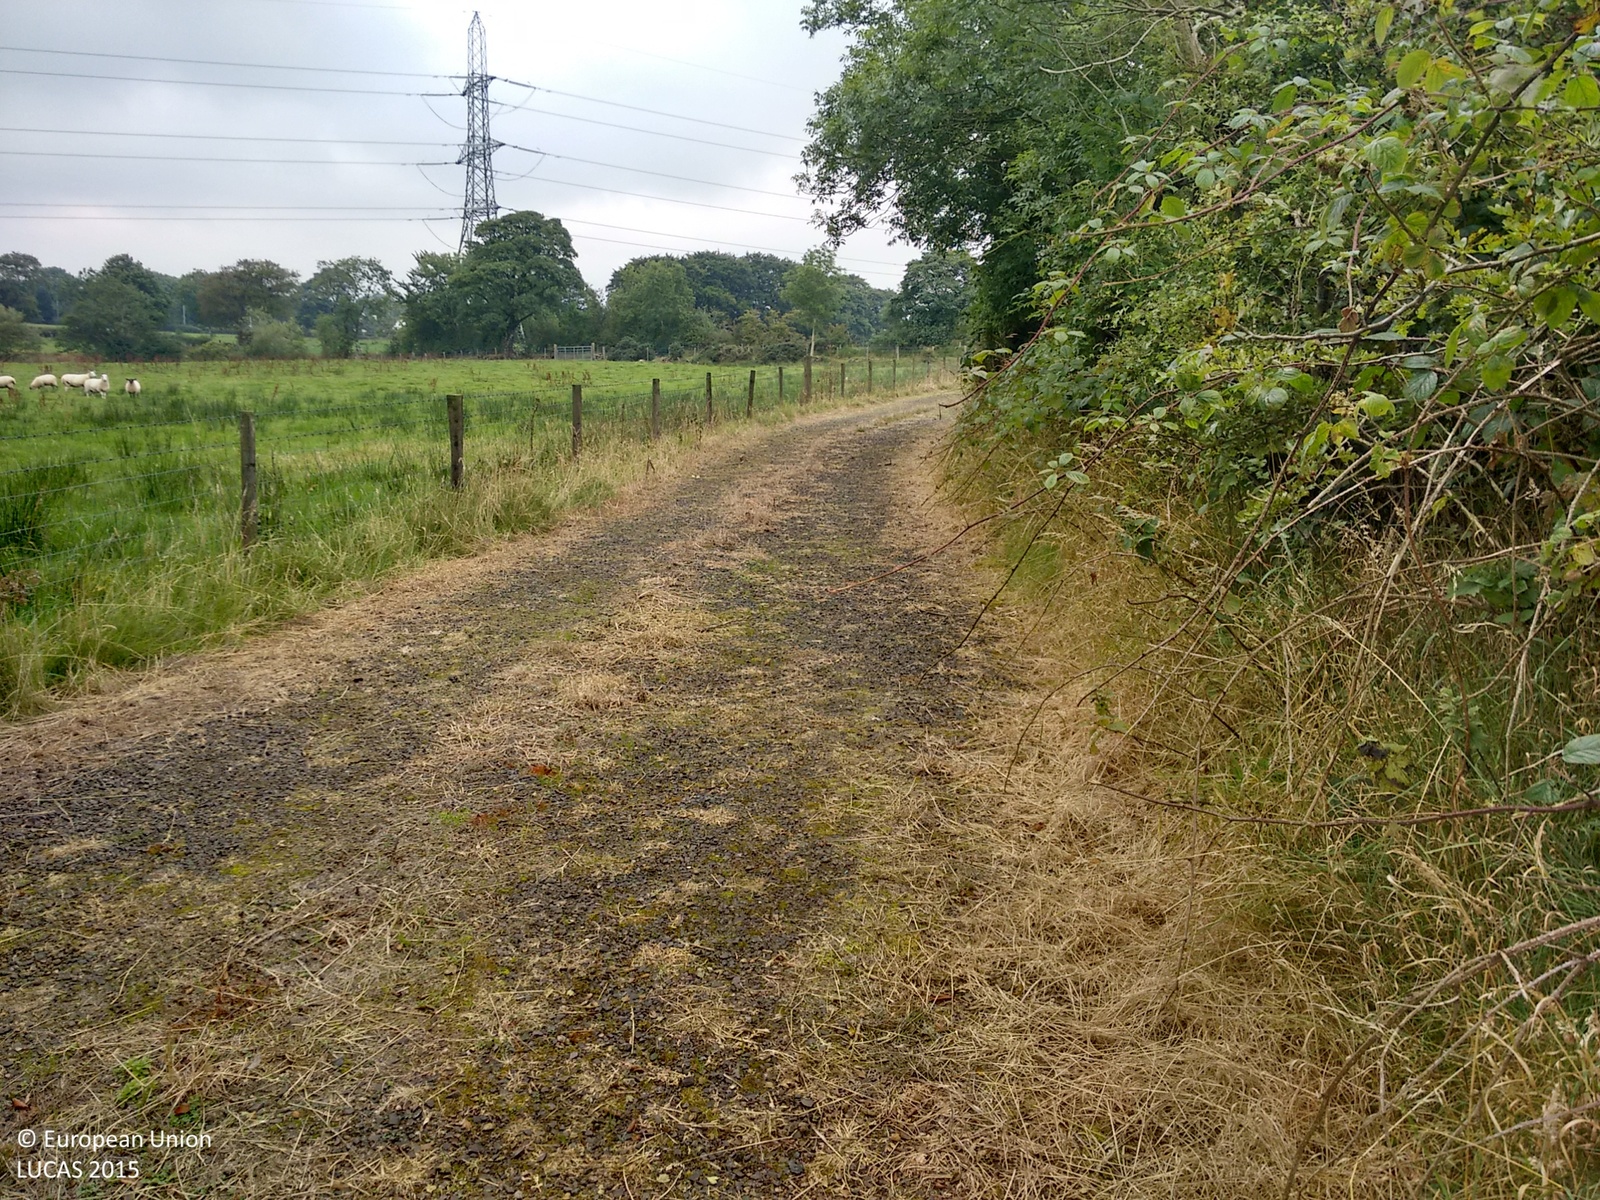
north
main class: Grassland
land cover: Grassland without tree/shrub cover
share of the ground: > 75 %
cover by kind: herbaceous plants 100 %
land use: Agriculture (excluding fallow land and kitchen gardens)
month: September
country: GB
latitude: 54.7859
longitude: -6.0174
